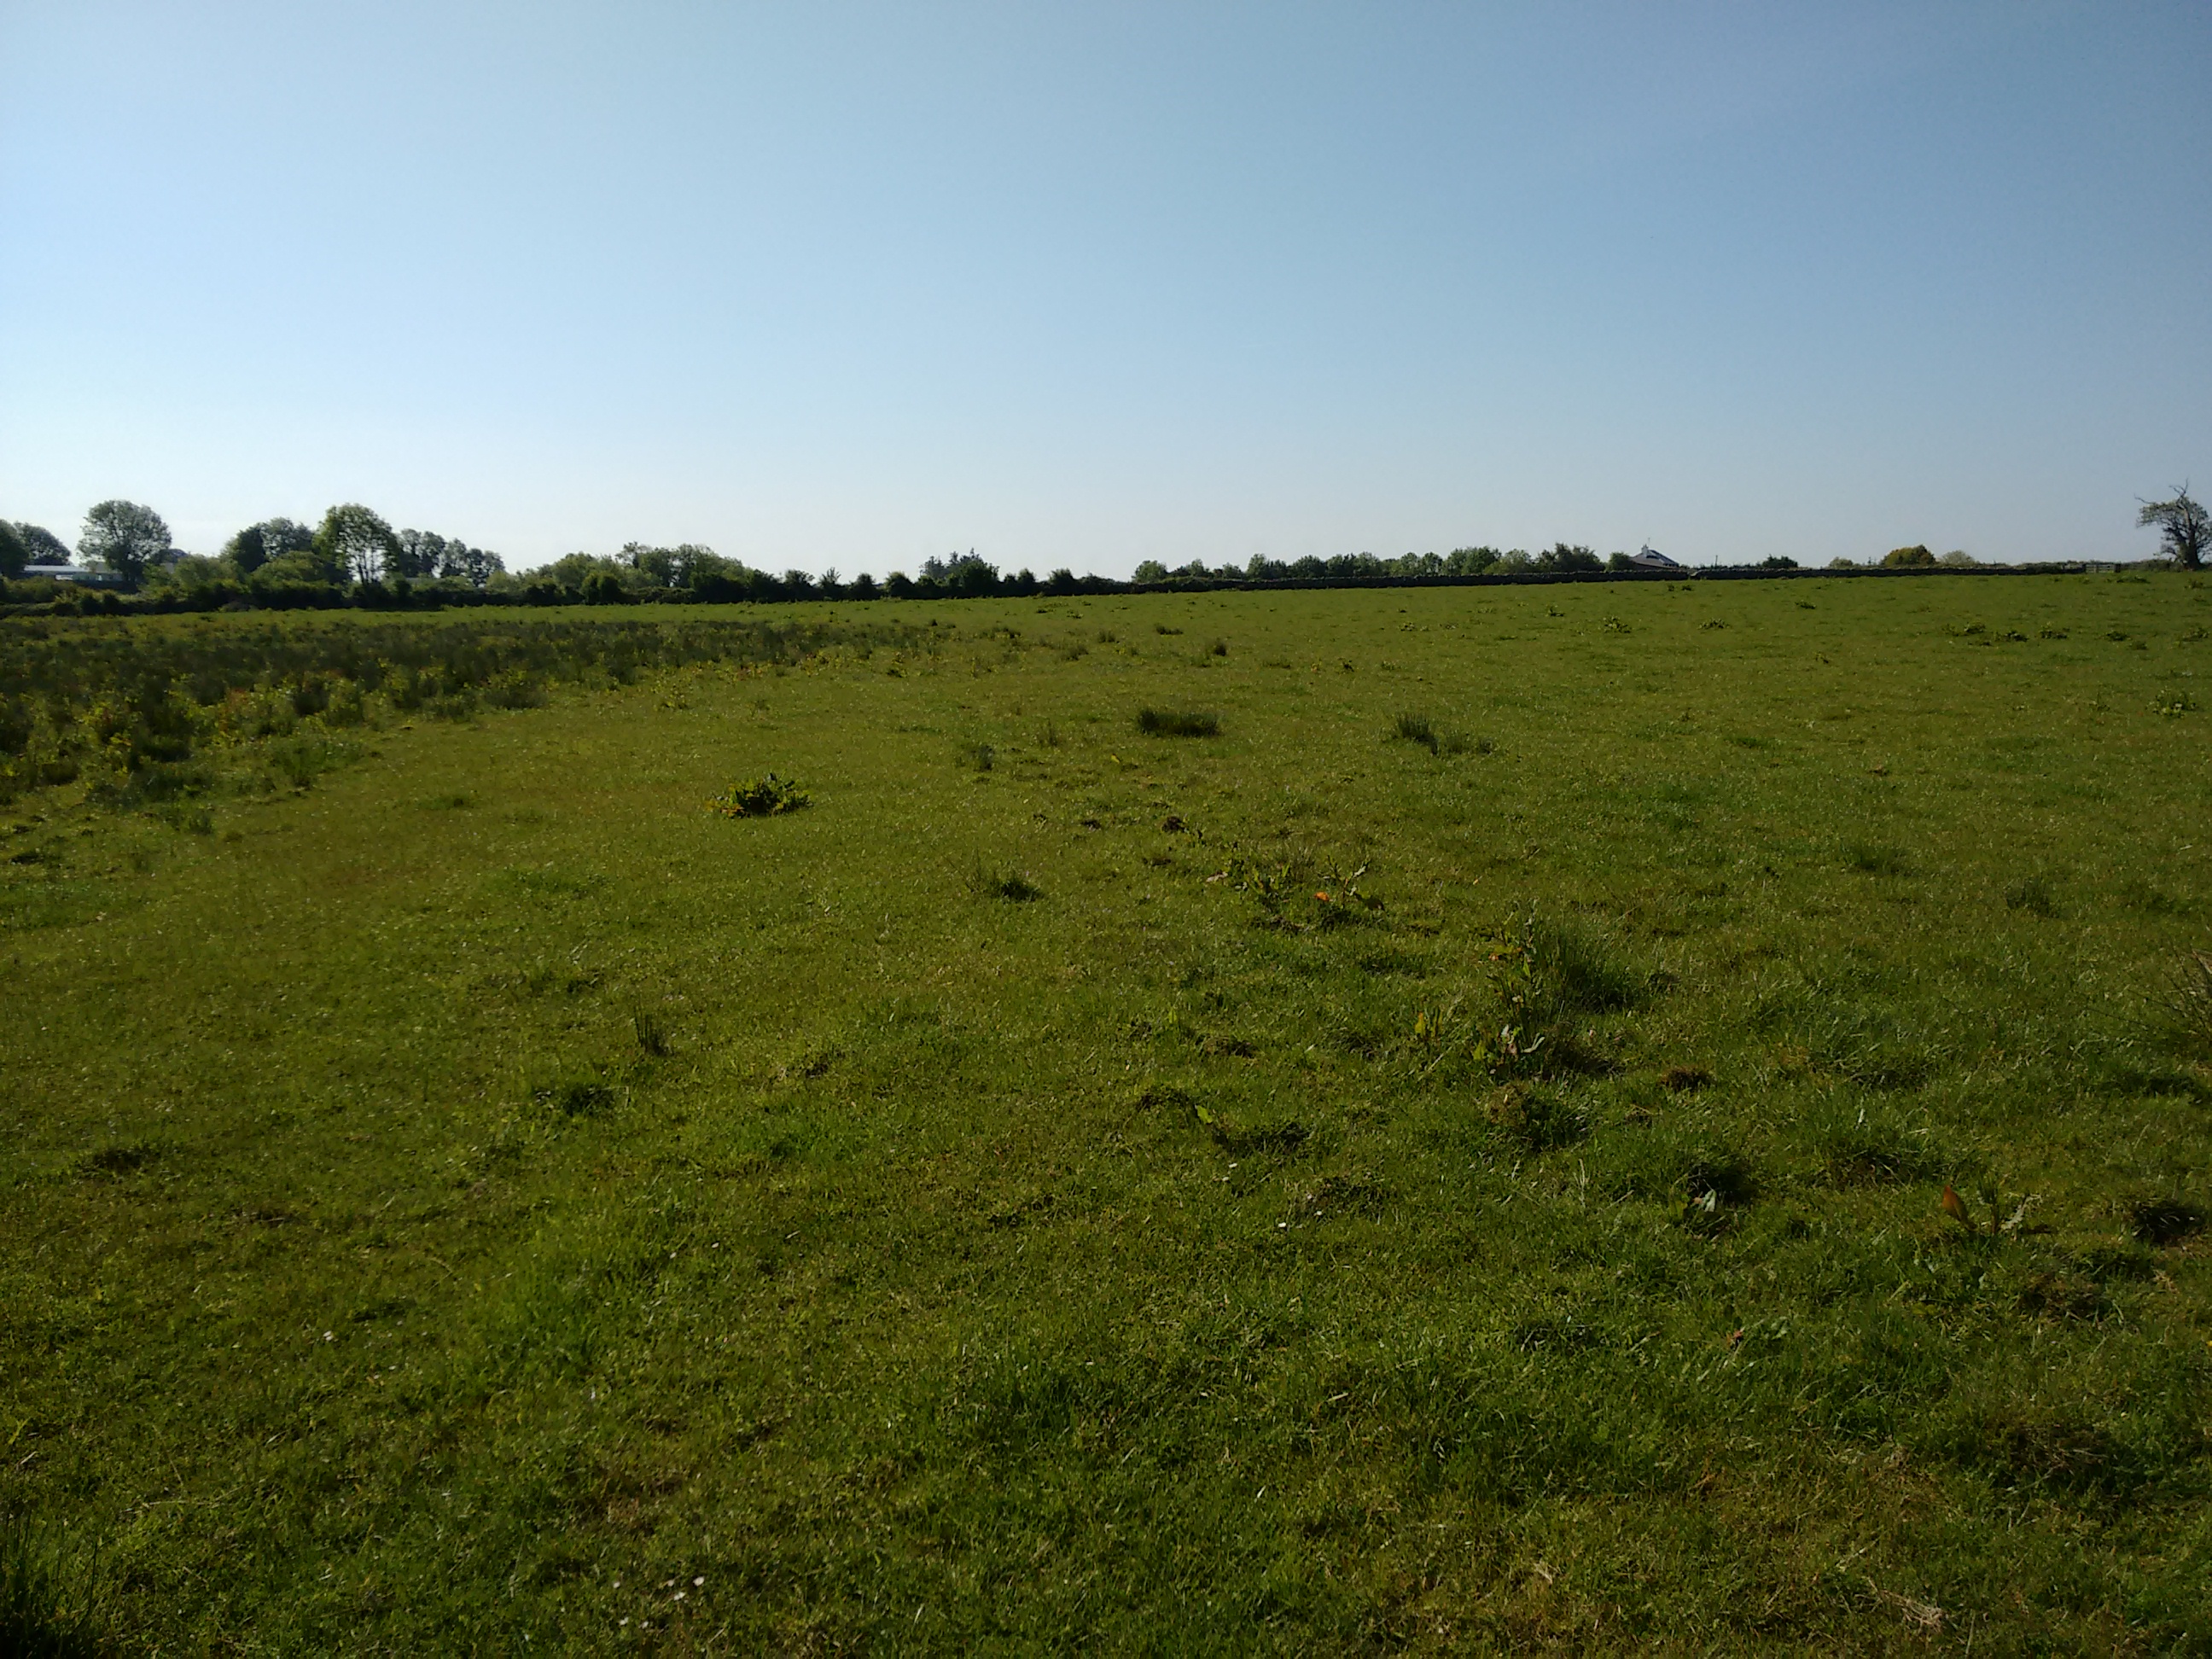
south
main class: Grassland
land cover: Grassland without tree/shrub cover
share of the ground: > 75 %
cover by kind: herbaceous plants 100 %
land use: Agriculture (excluding fallow land and kitchen gardens)
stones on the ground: < 10 %
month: June
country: IE
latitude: 53.5284
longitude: -9.0878
